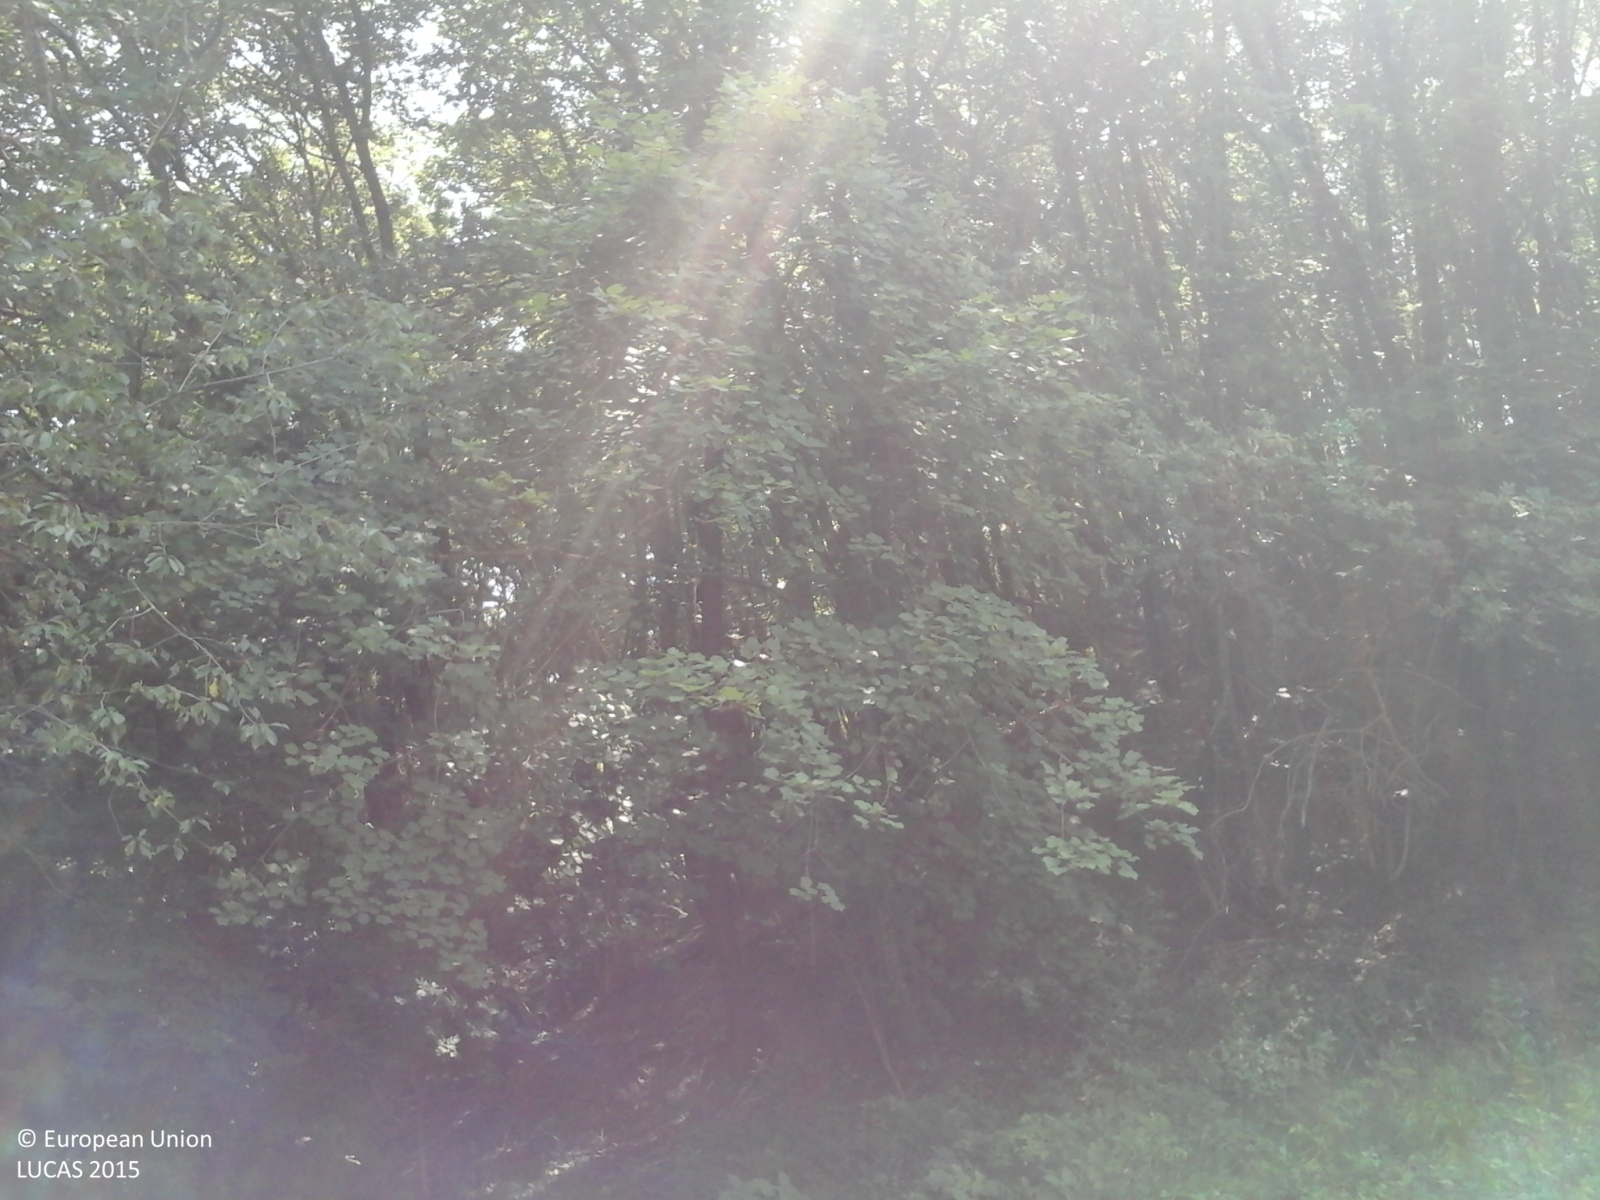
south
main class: Grassland
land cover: Grassland without tree/shrub cover
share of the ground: > 75 %
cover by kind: herbaceous plants 100 %
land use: Agriculture (excluding fallow land and kitchen gardens)
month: July
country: IT
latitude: 44.4764
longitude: 10.2885
